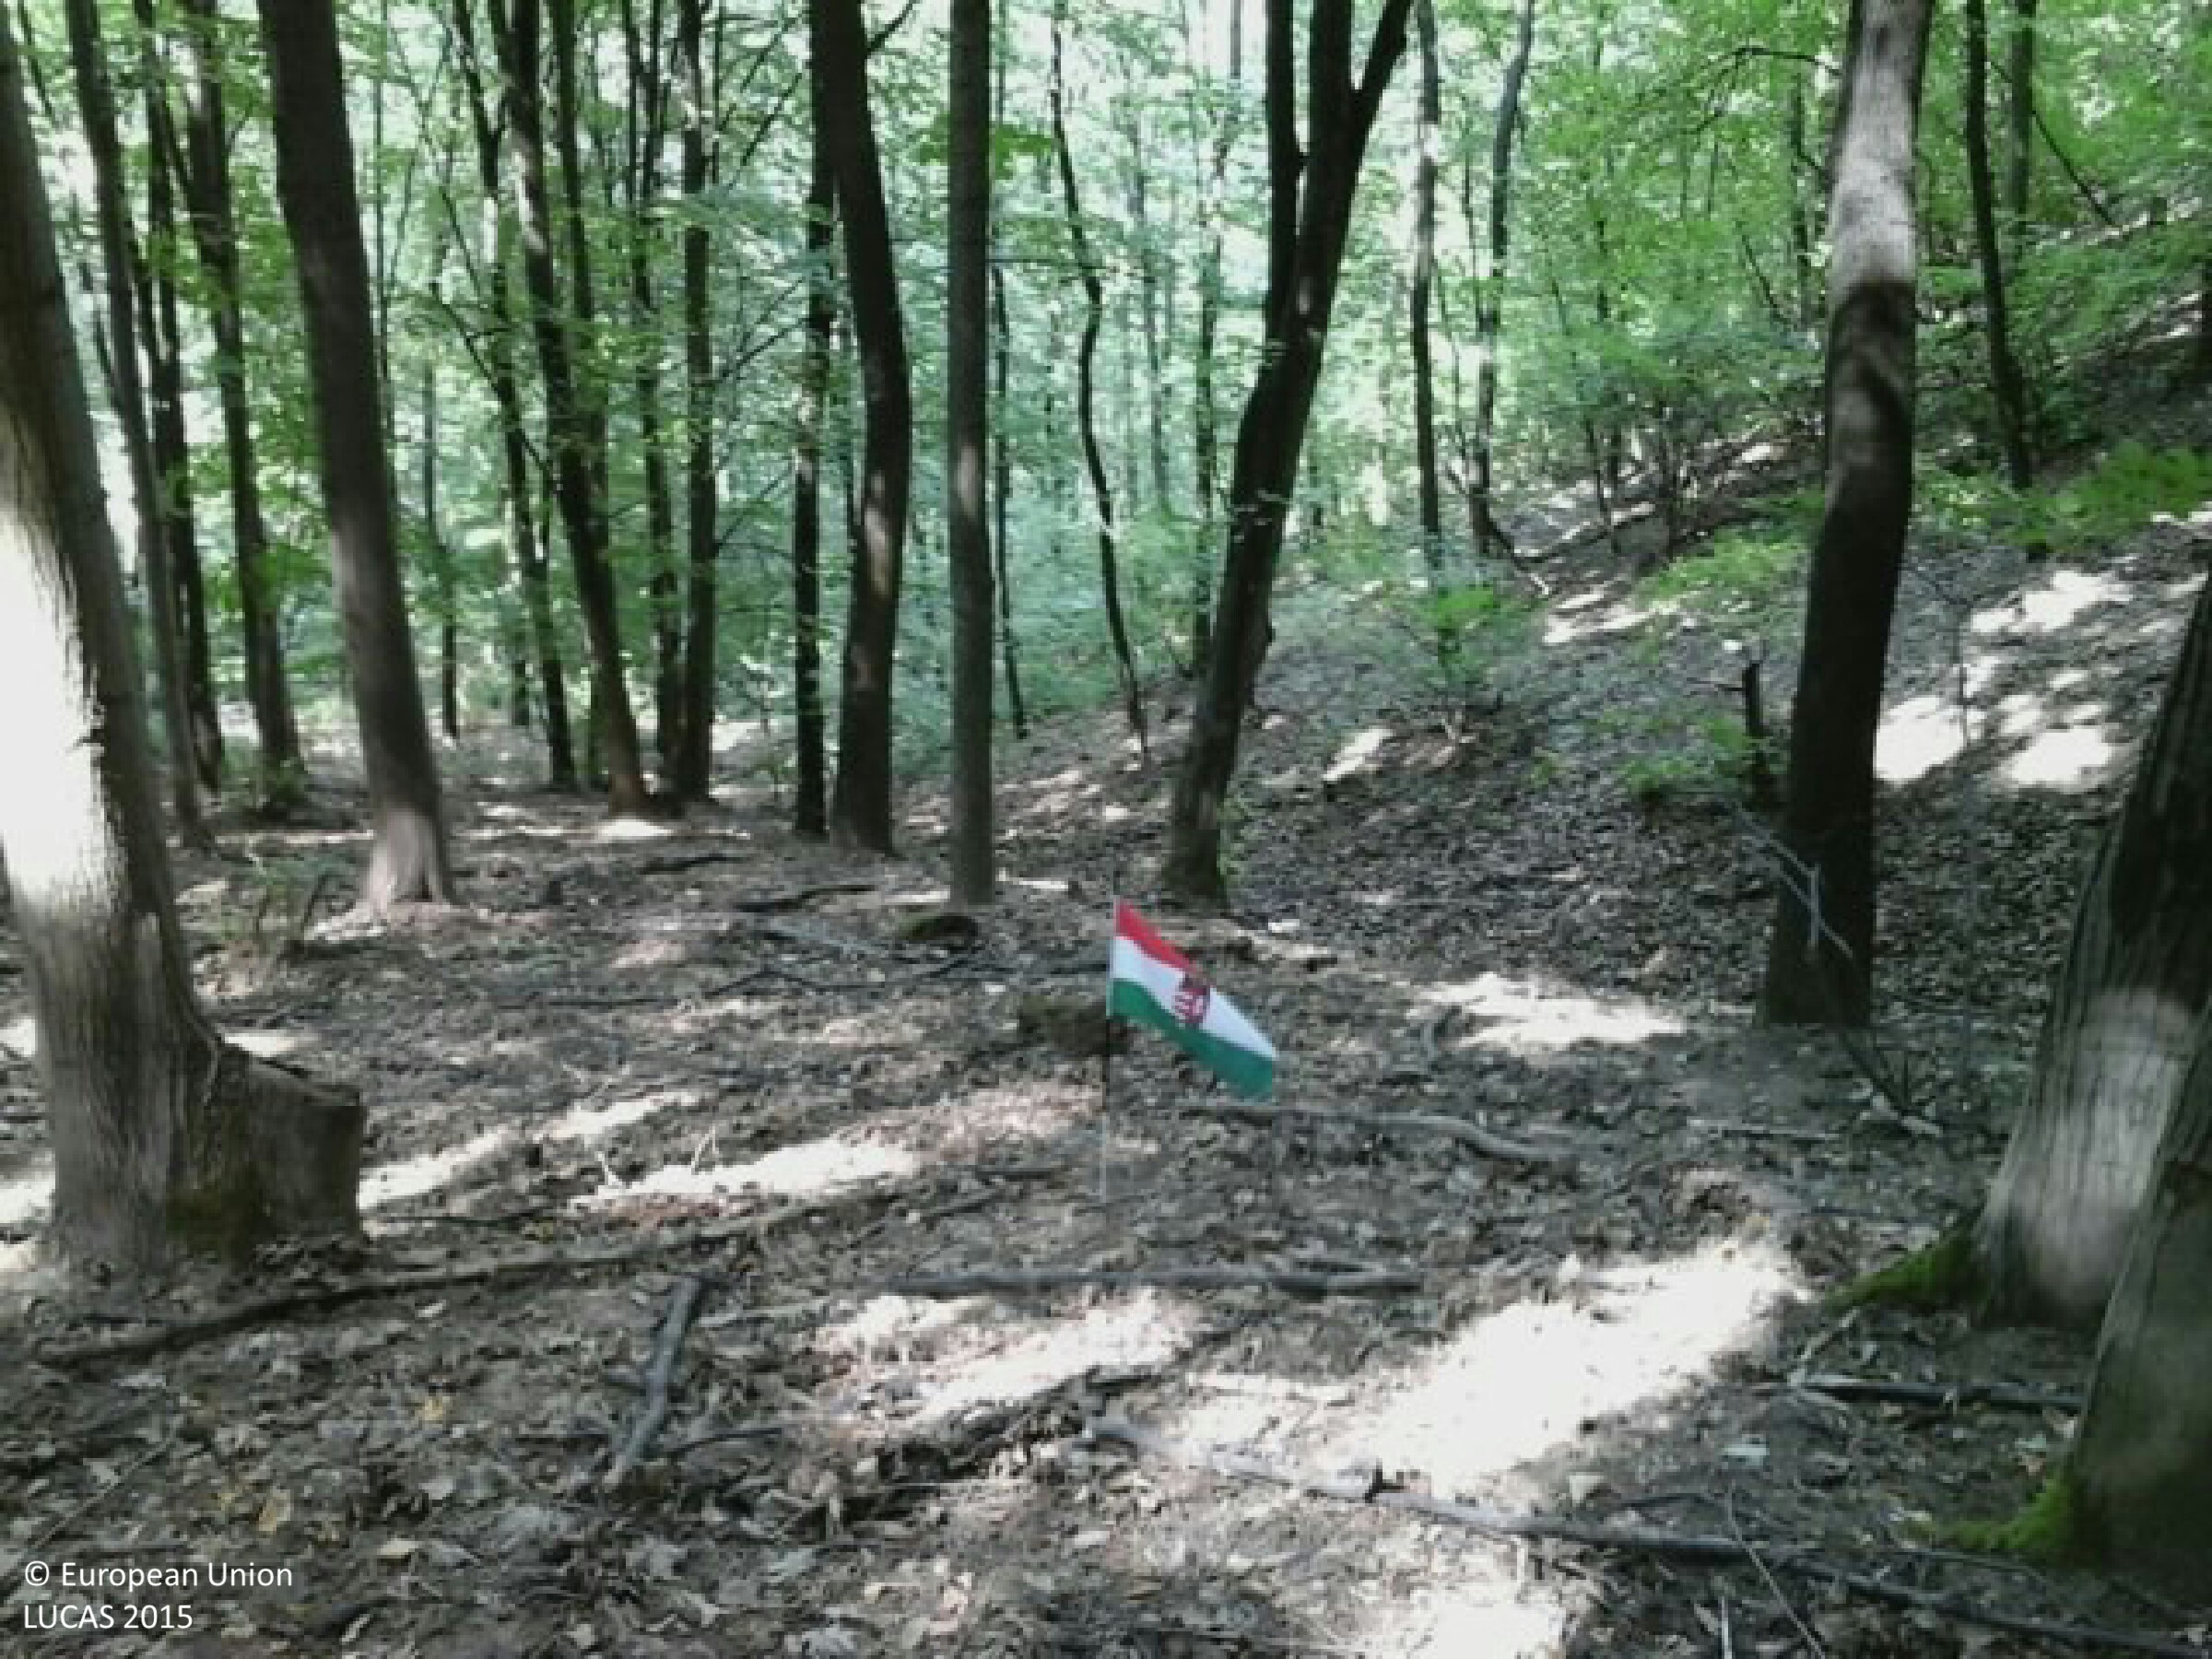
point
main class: Woodland
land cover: Broadleaved woodland
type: beech forest
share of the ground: 50 - 75 %
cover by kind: broadleaved forest trees 100 %
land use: Forestry
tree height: > 5 m
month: July
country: HU
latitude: 47.7958
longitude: 19.2723
